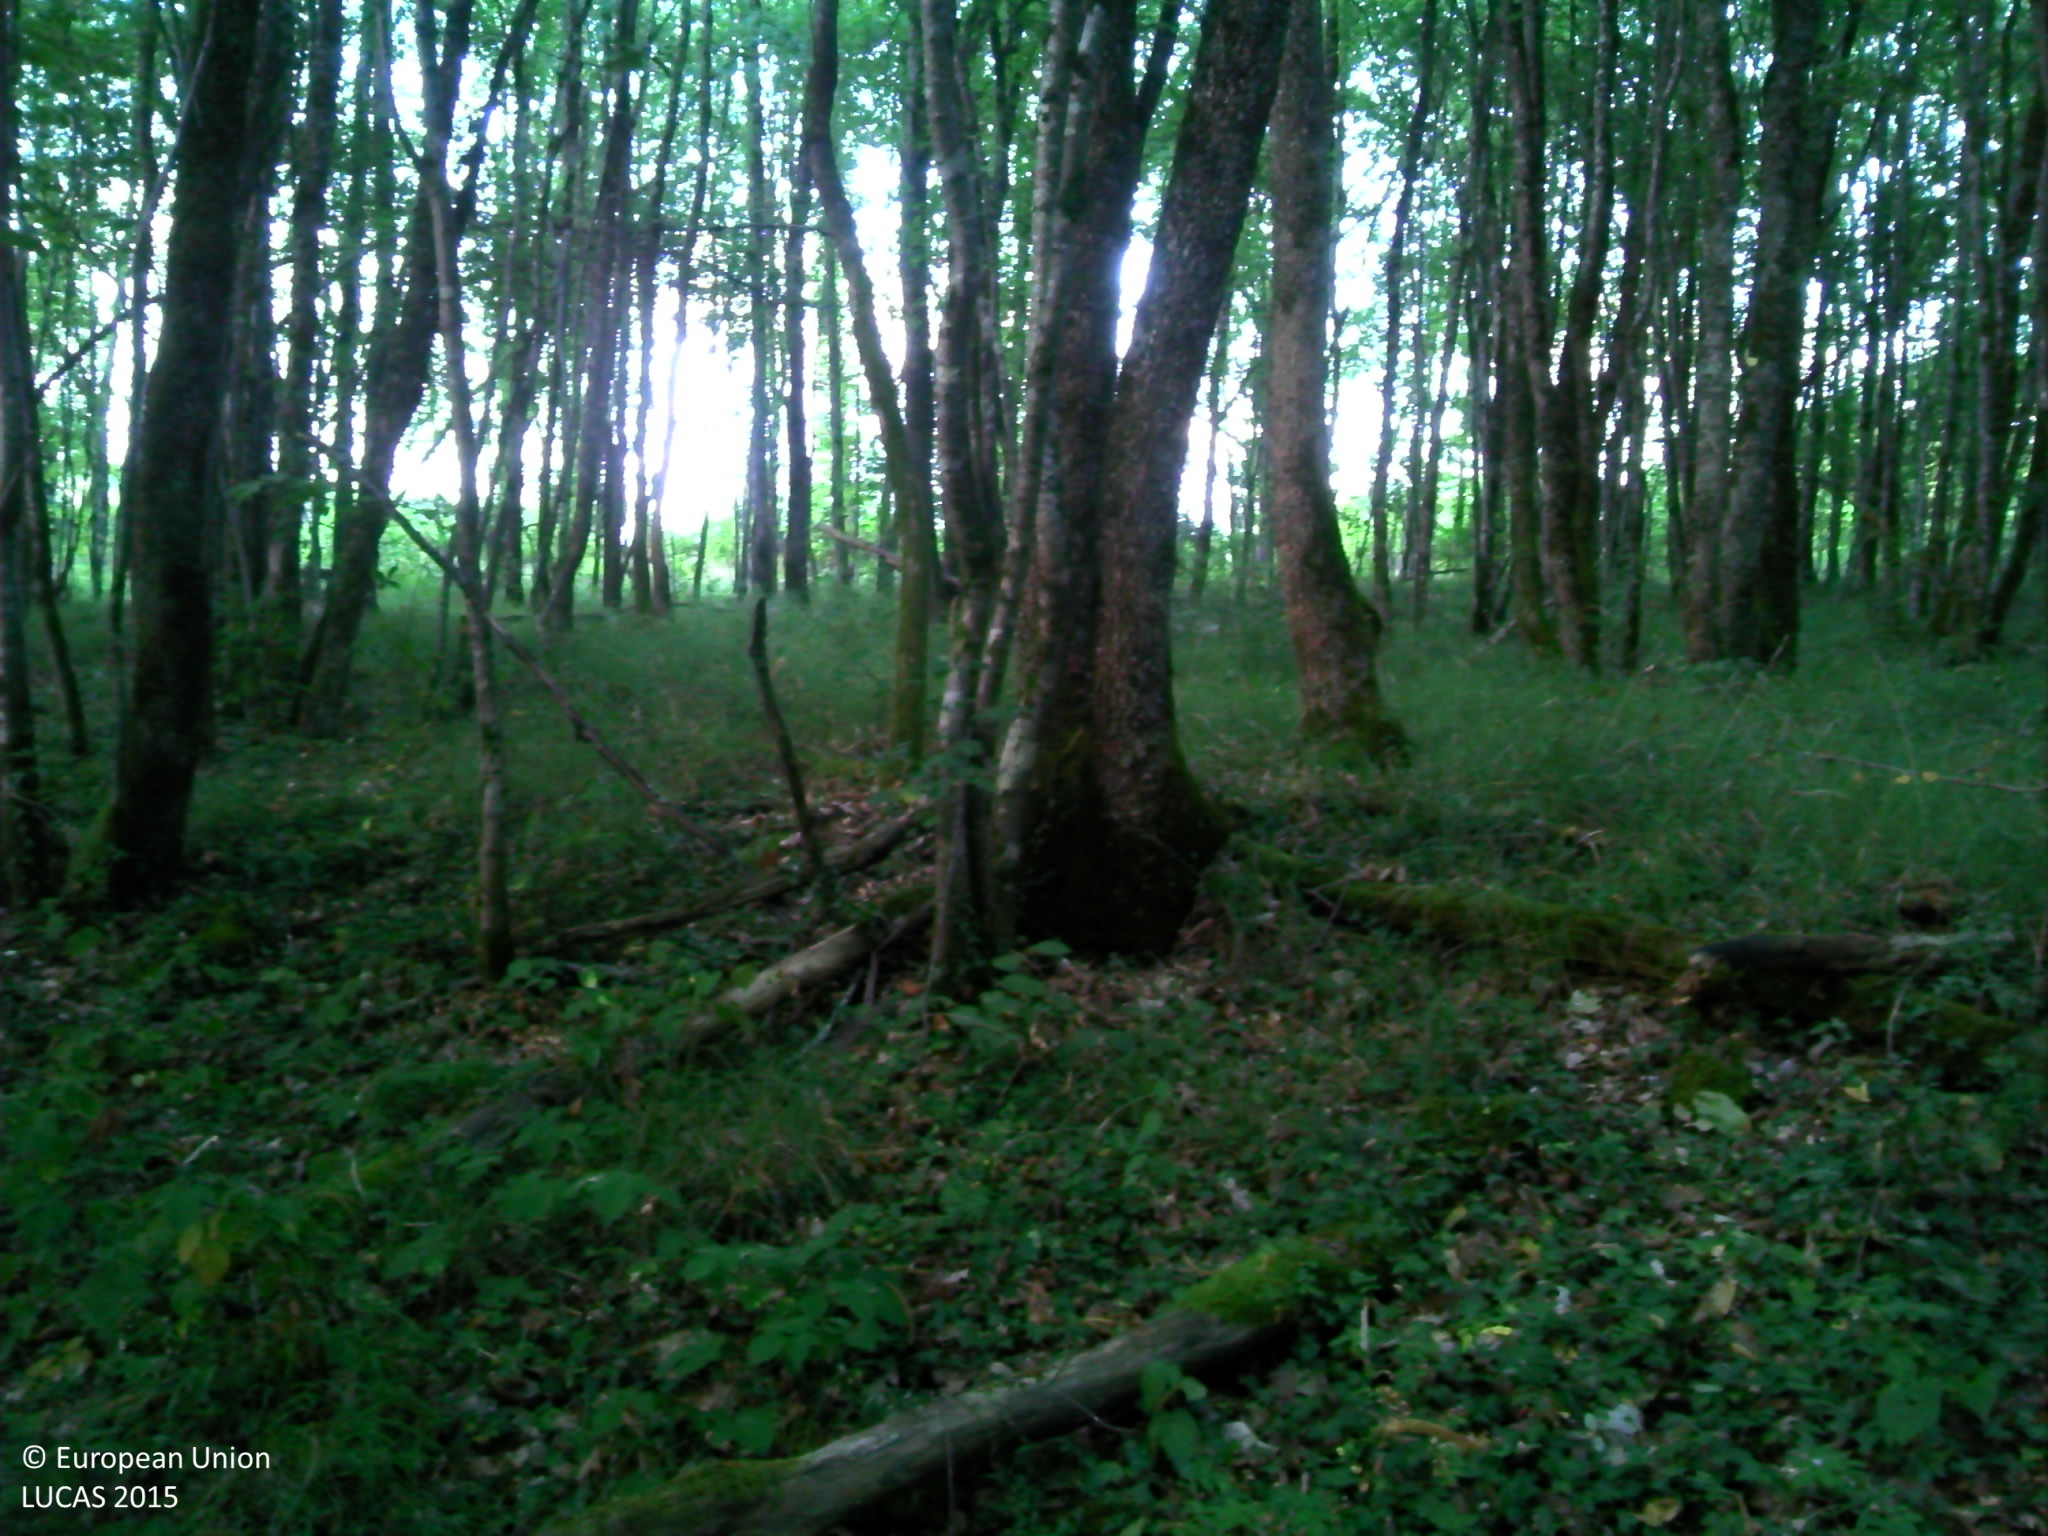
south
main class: Woodland
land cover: Broadleaved woodland
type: thermophilous deciduous forest
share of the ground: > 75 %
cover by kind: broadleaved forest trees 90 %, herbaceous plants 10 %
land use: Forestry
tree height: > 5 m
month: July
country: FR
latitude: 44.3270
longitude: 0.6519
